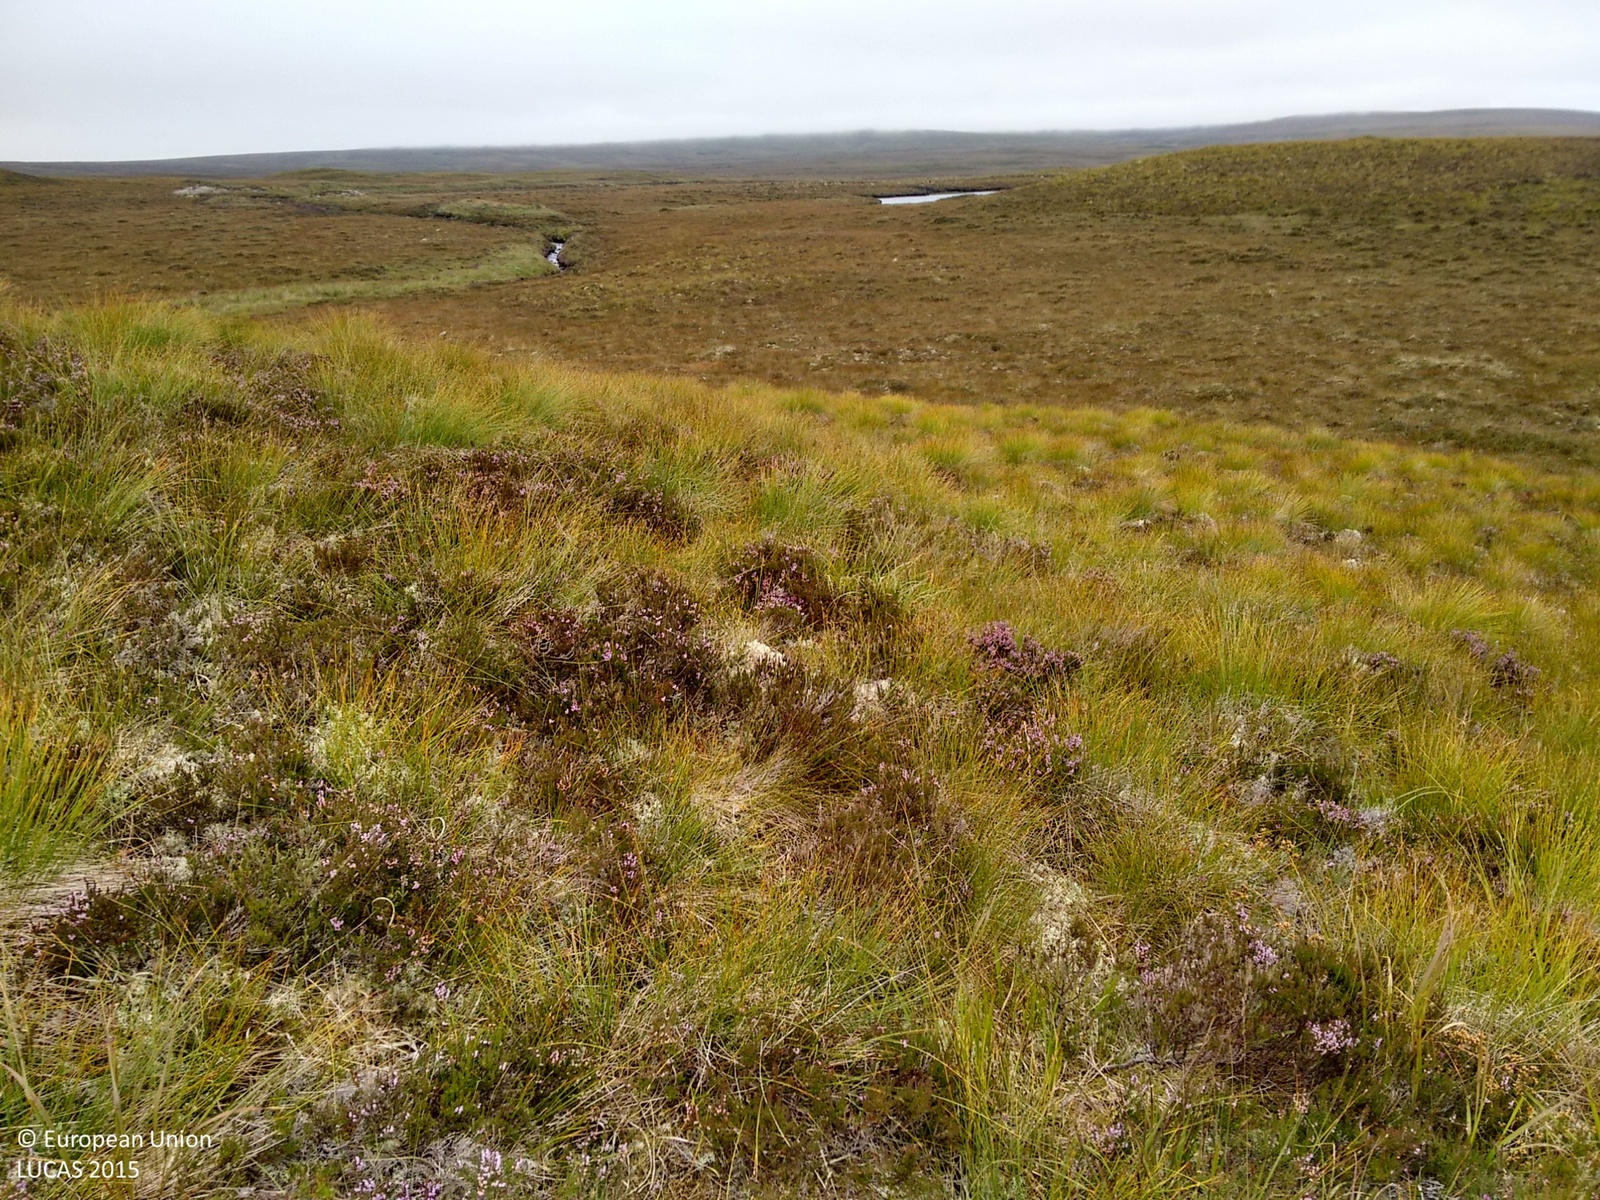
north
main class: Shrubland
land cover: Shrubland without tree cover
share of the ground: 50 - 75 %
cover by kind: shrubs 60 %, herbaceous plants 40 %
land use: Semi-natural and natural areas not in use
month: September
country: GB
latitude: 58.1935
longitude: -4.5301
